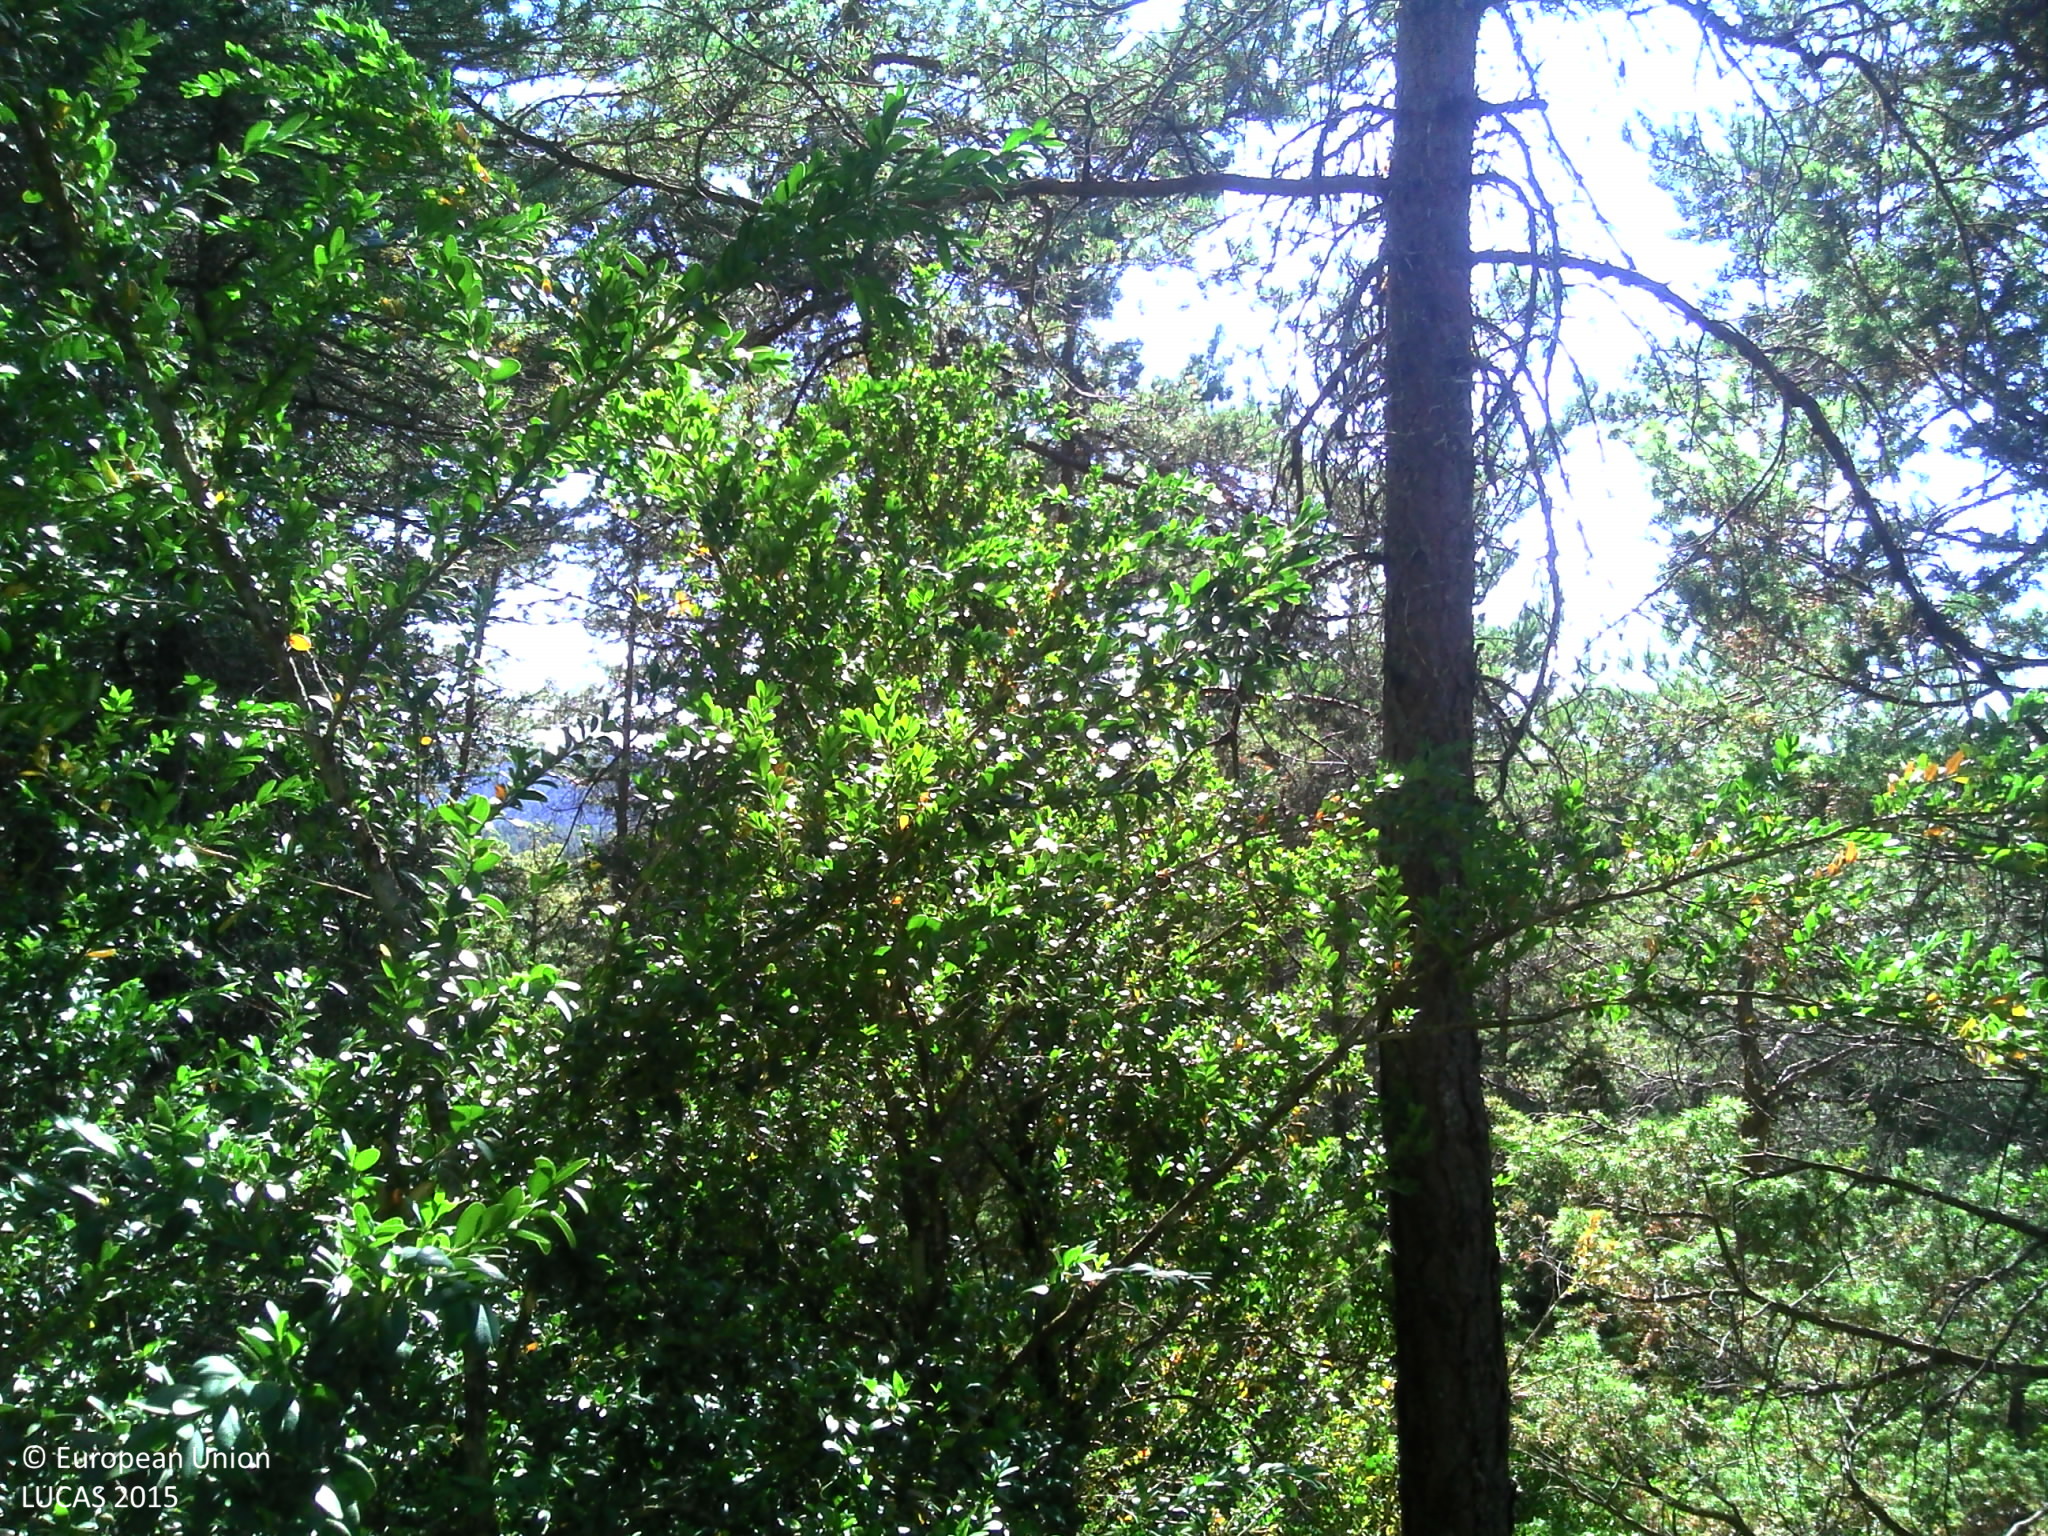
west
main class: Woodland
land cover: Pine dominated coniferous woodland
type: alpine coniferous forest
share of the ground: > 75 %
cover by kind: coniferous forest trees 75 %, shrubs 10 %, herbaceous plants 10 %, broadleaved forest trees 5 %
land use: Forestry
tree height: > 5 m
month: July
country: FR
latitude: 44.3670
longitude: 3.2667
